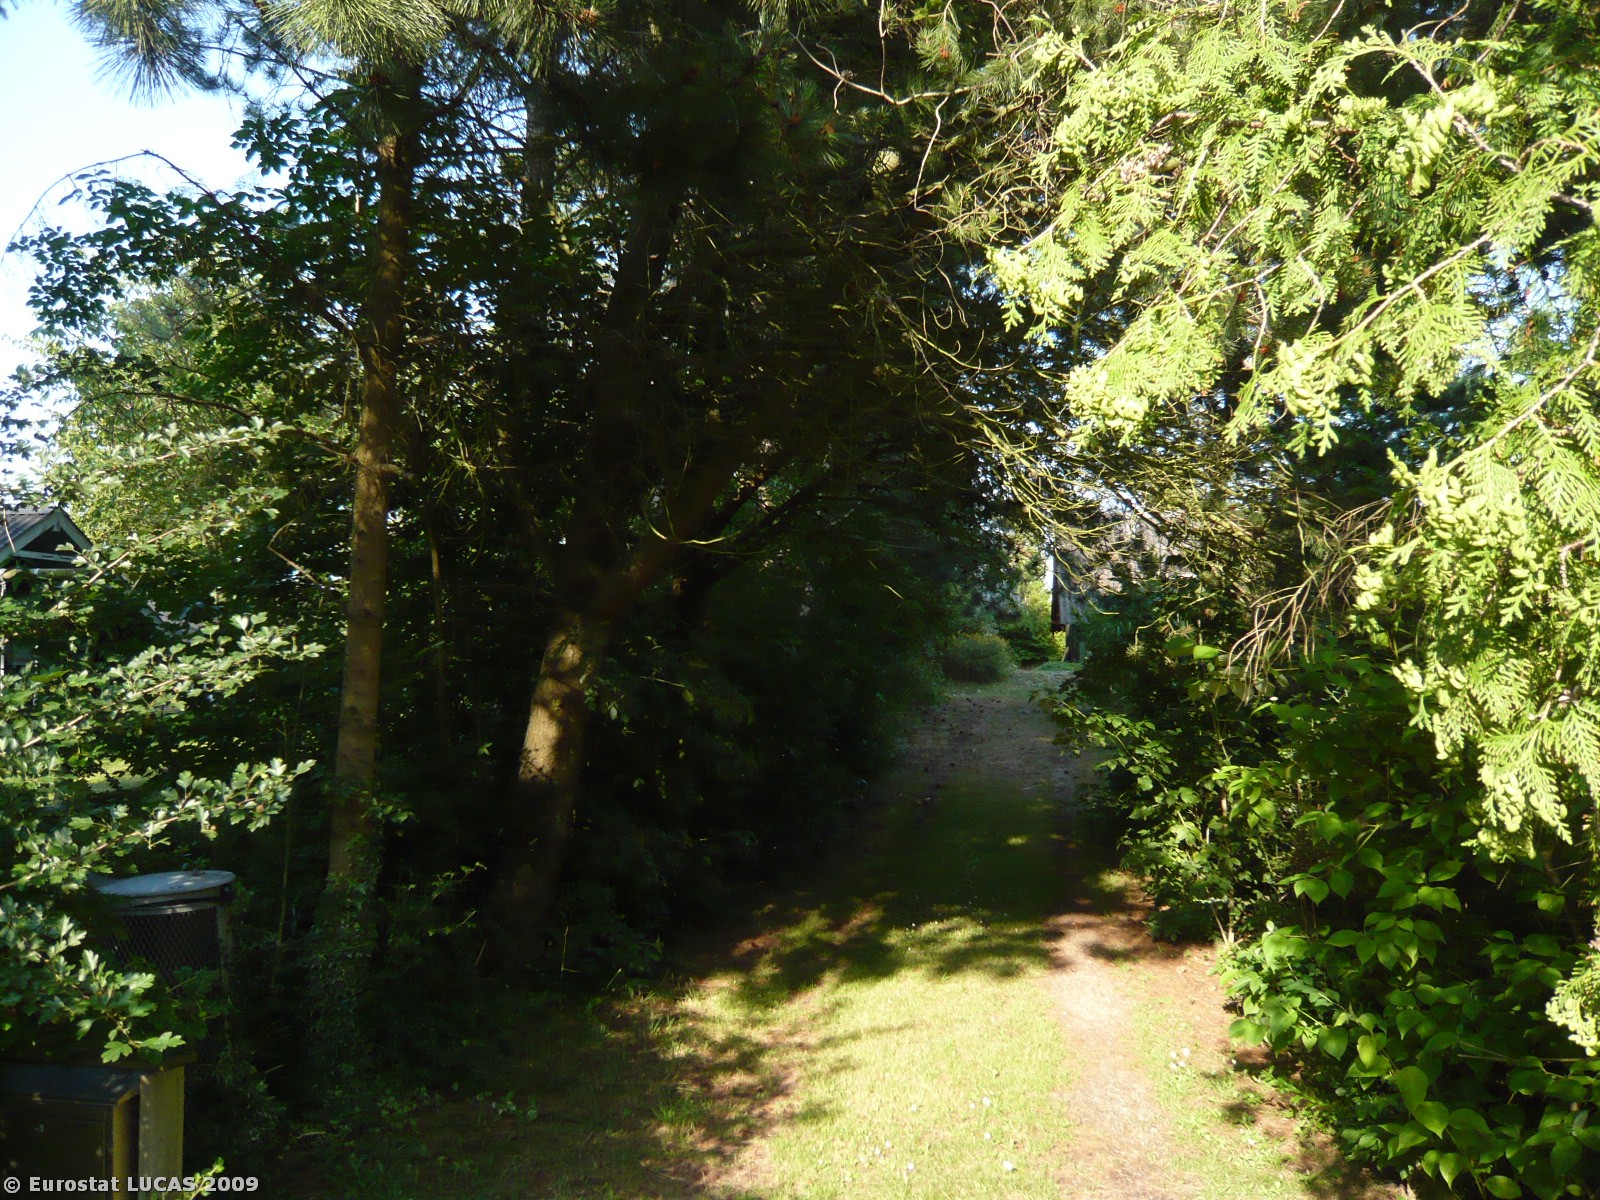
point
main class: Woodland
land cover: Coniferous woodland
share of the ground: > 75 %
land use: Holiday camps
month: July
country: DK
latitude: 55.7997
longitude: 11.6415
